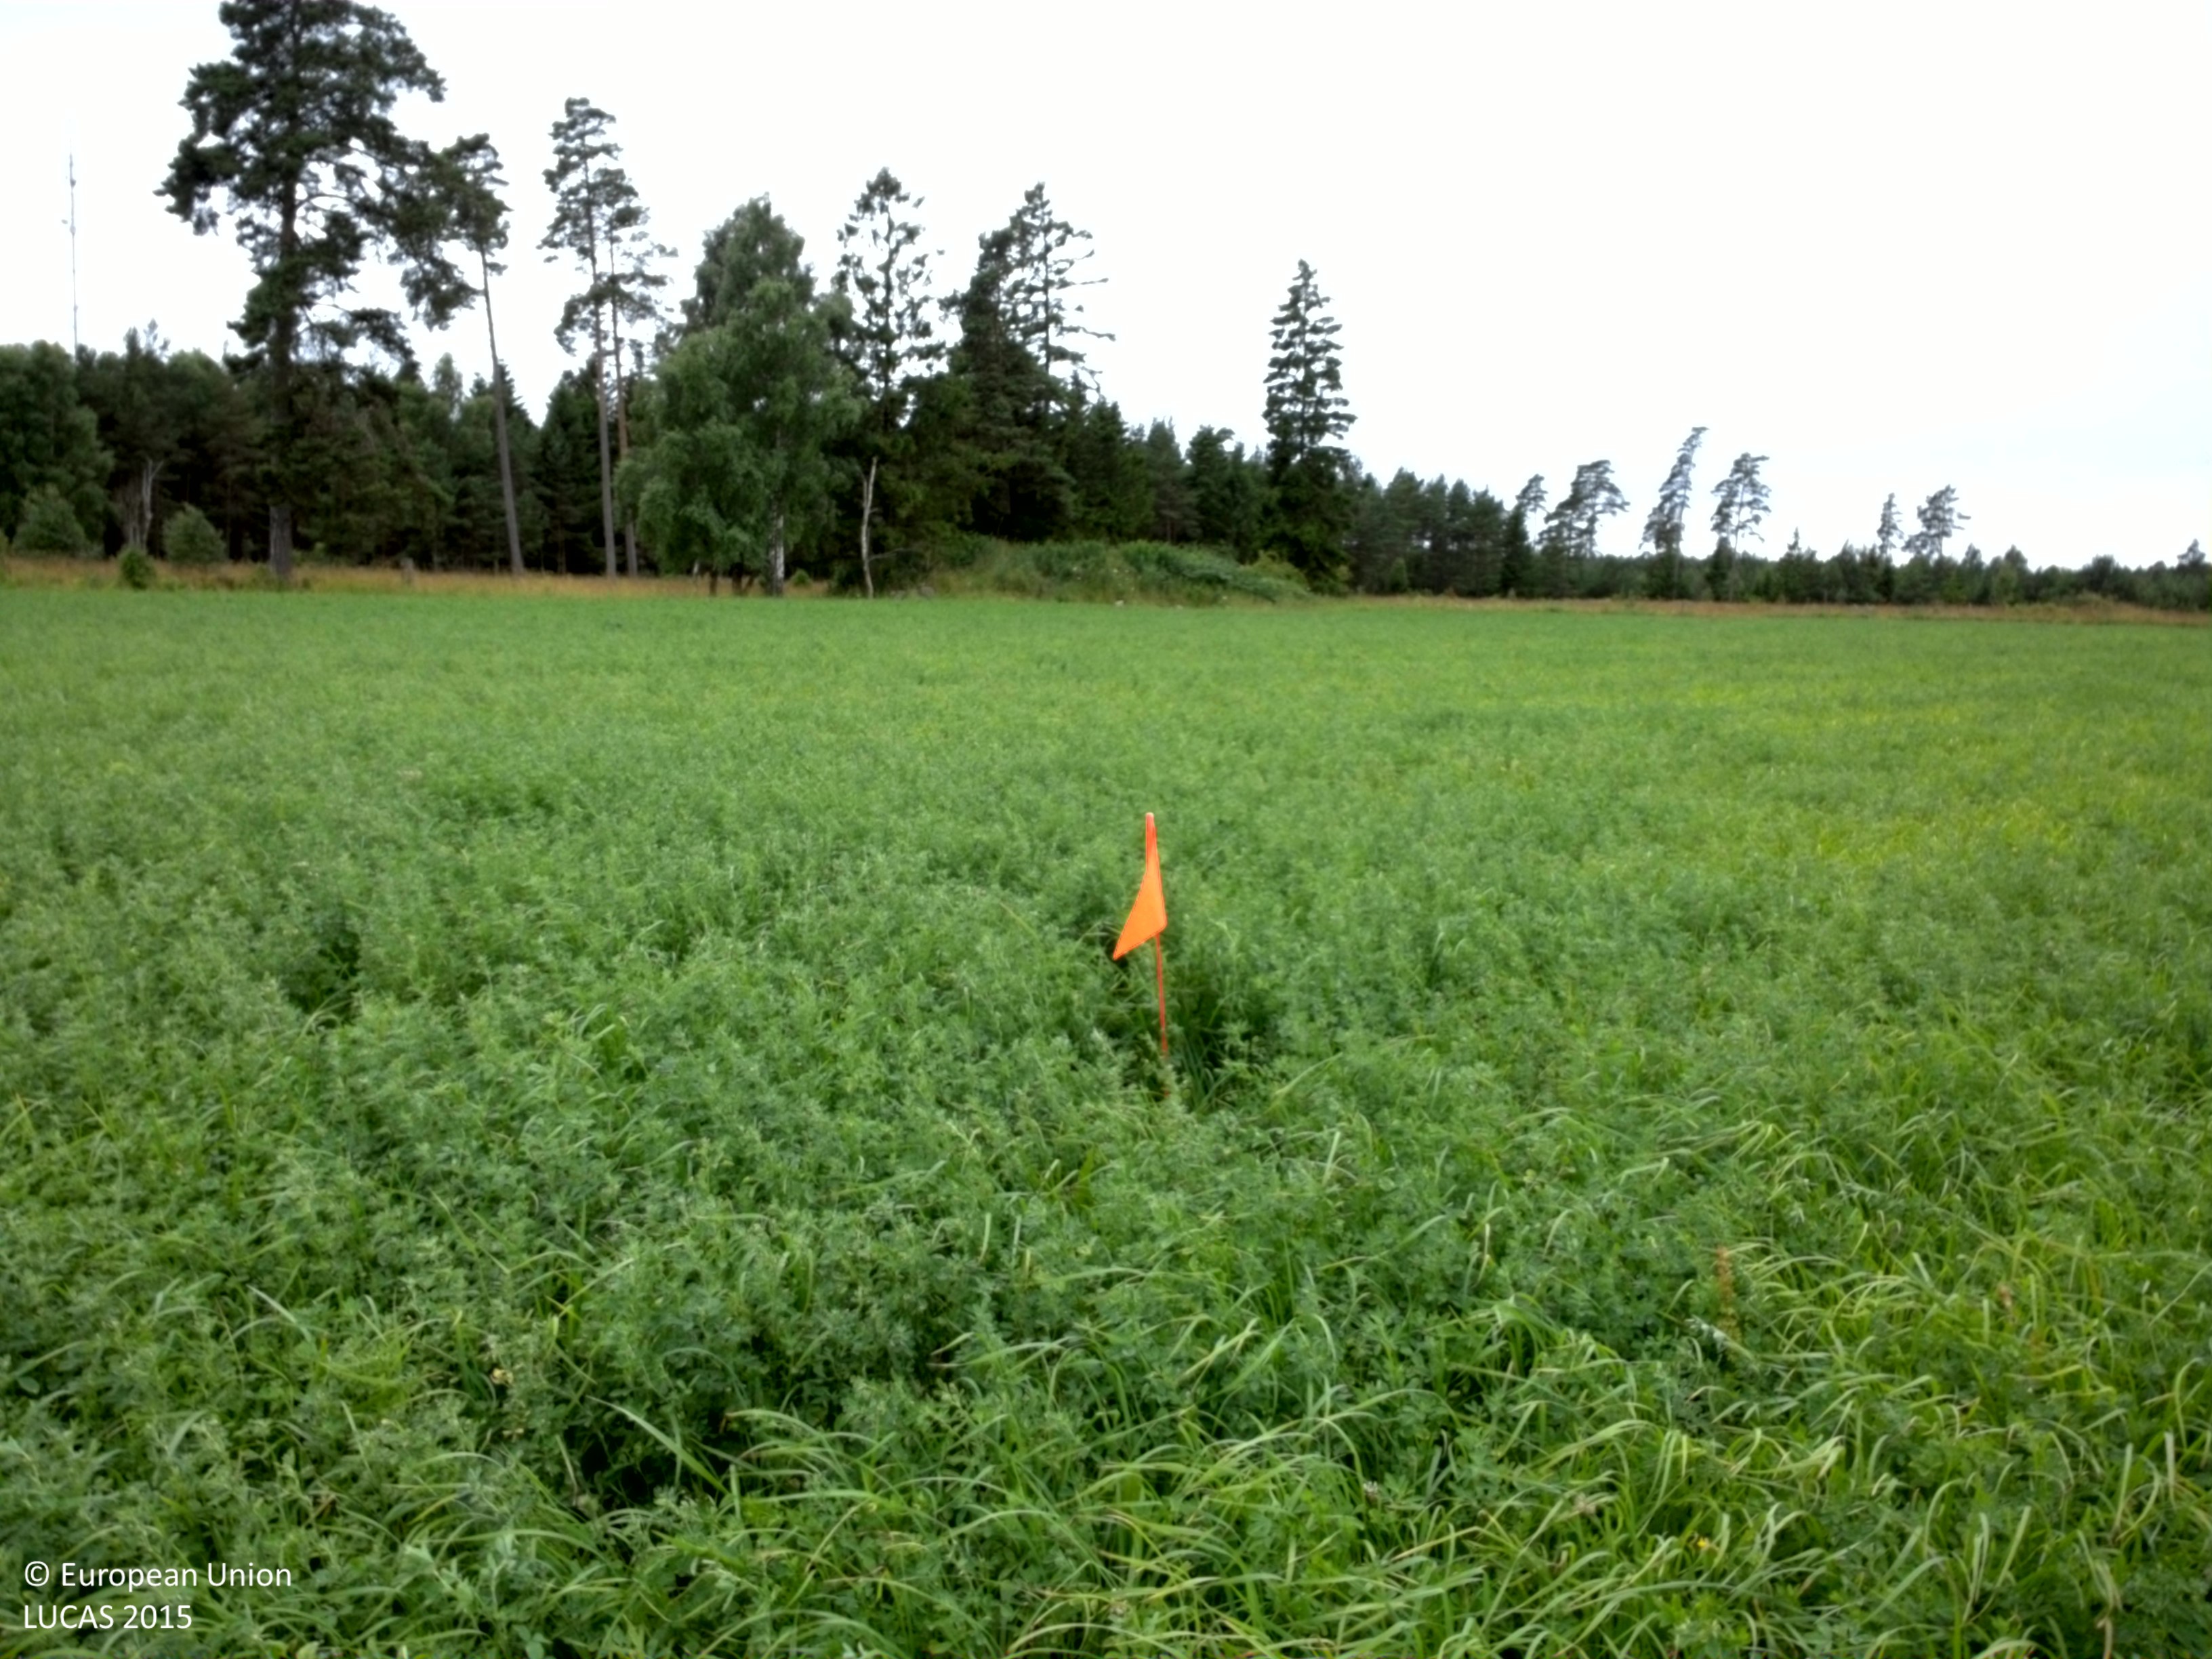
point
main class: Cropland
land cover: Lucerne
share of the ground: > 75 %
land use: Agriculture (excluding fallow land and kitchen gardens)
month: July
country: SE
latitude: 57.4827
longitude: 18.1628
